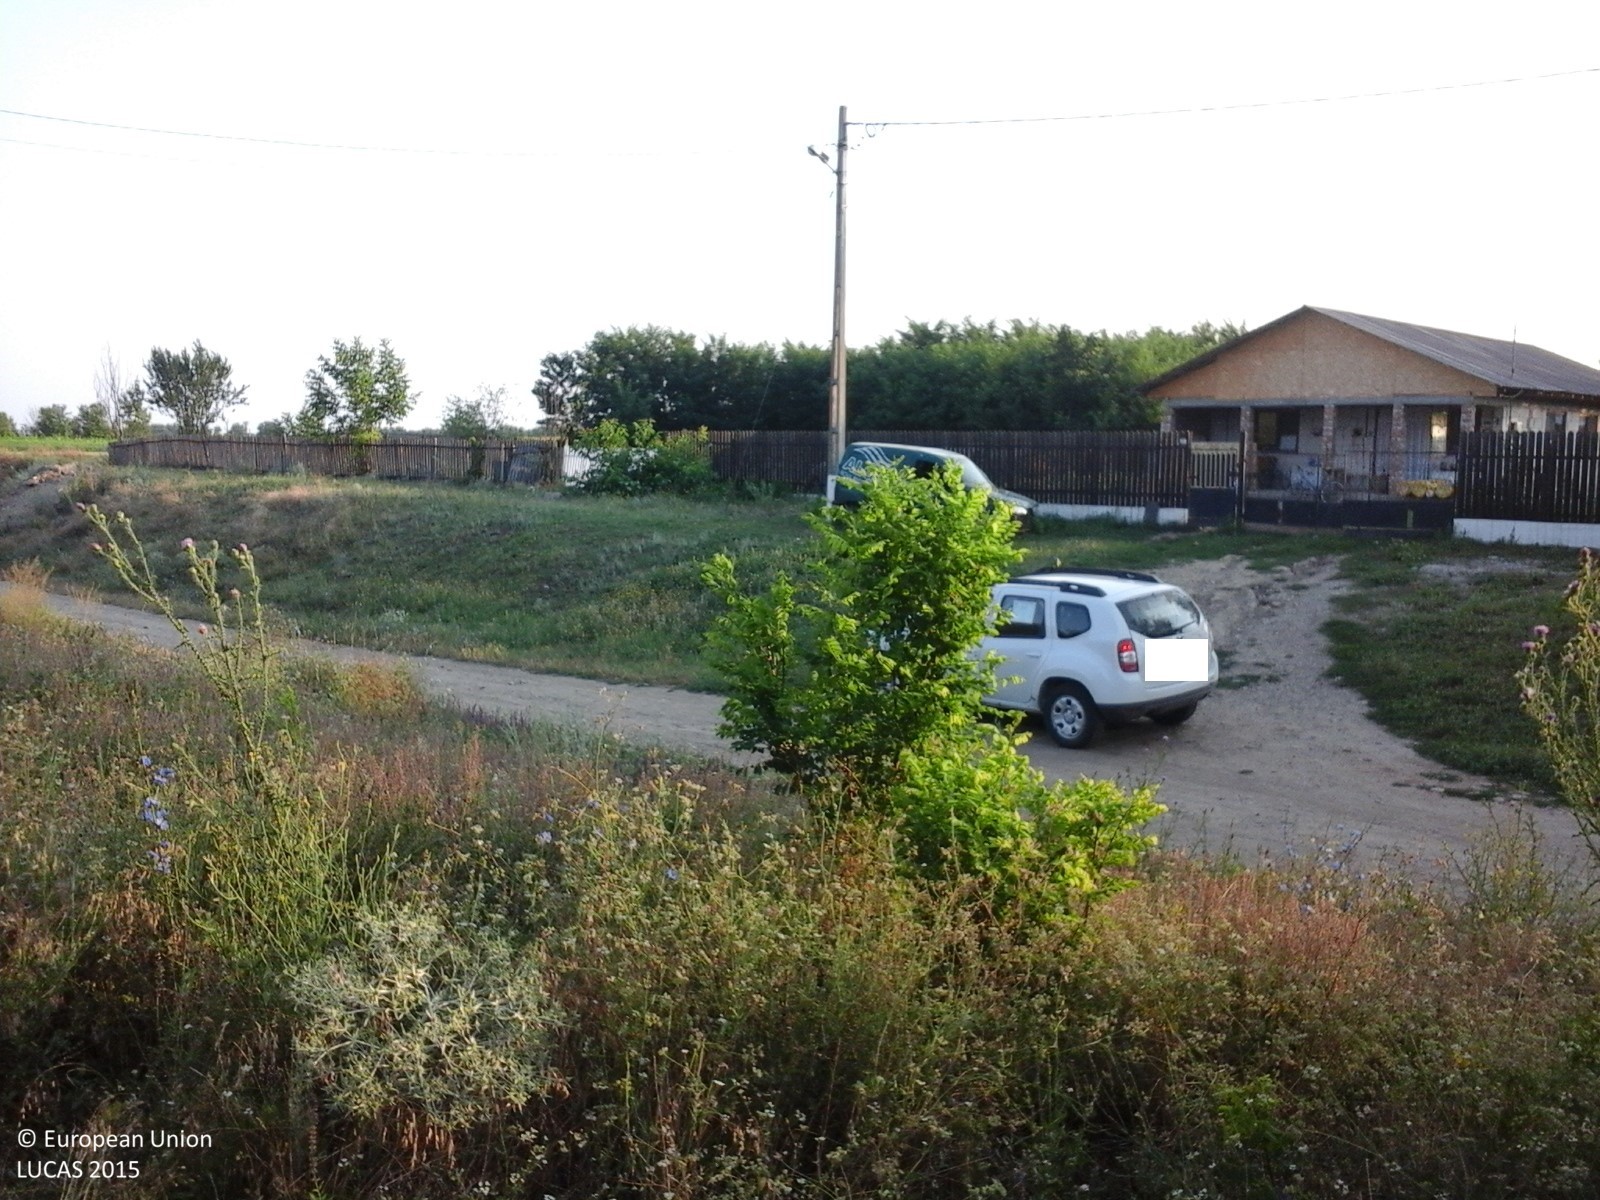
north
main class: Grassland
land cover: Grassland without tree/shrub cover
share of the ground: > 75 %
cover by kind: herbaceous plants 100 %
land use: Agriculture (excluding fallow land and kitchen gardens)
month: July
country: RO
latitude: 44.6011
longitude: 27.0515
